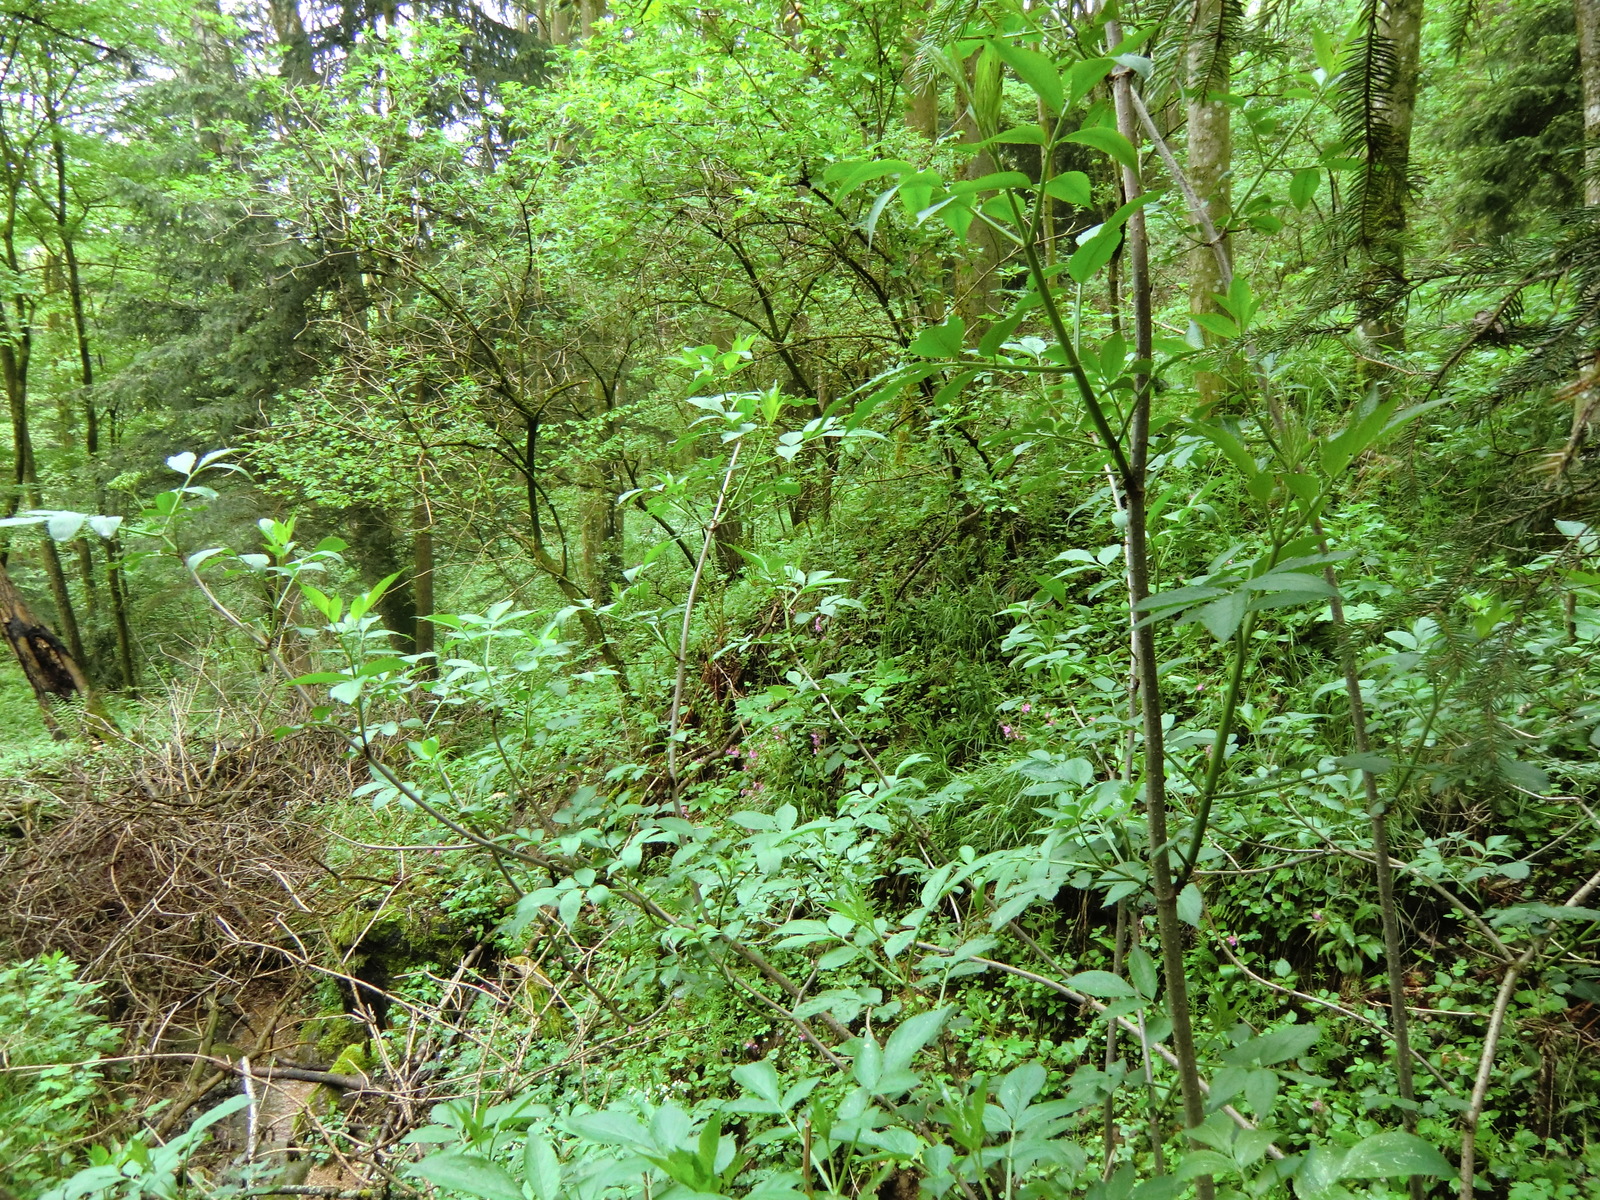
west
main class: Woodland
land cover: Spruce dominated mixed woodland
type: mountainous beech forest
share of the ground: 50 - 75 %
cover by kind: coniferous forest trees 35 %, broadleaved forest trees 35 %, shrubs 15 %, herbaceous plants 15 %
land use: Forestry
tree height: > 5 m
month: May
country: AT
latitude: 48.2831
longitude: 14.7580
